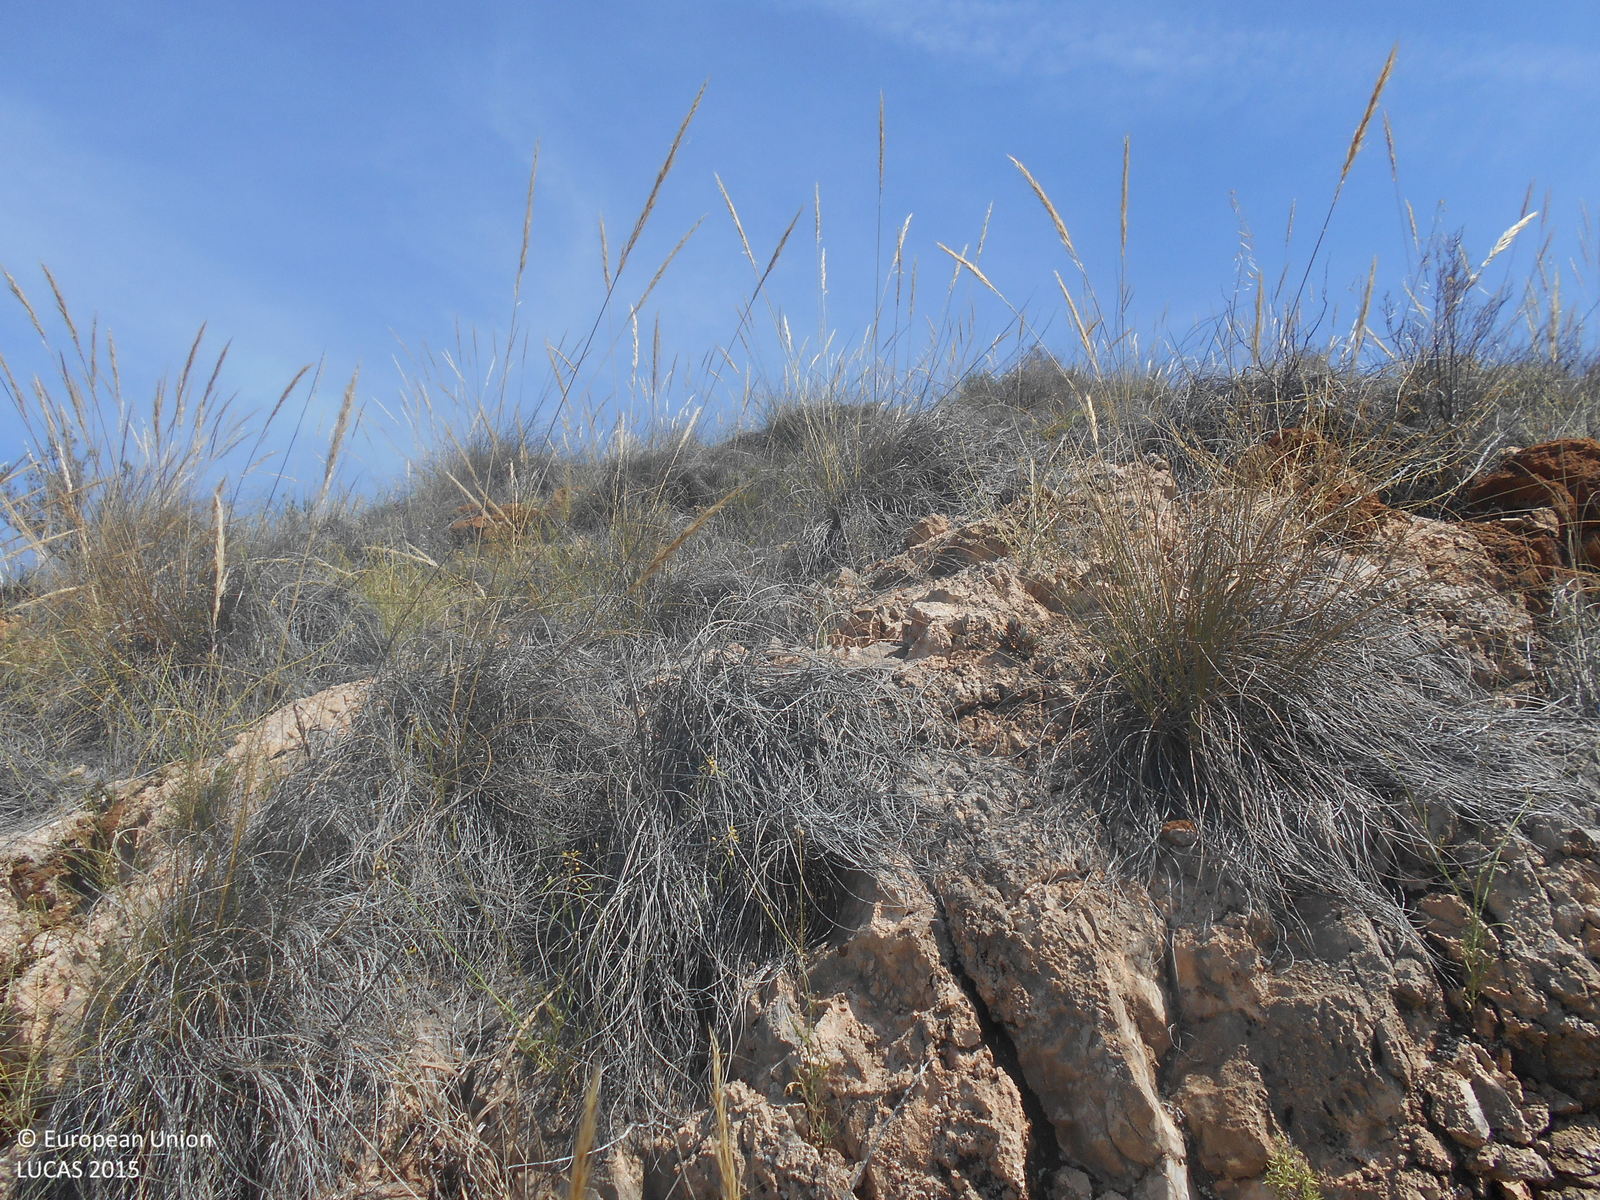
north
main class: Shrubland
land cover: Shrubland without tree cover
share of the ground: > 75 %
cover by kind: shrubs 70 %, consolidated bare surface 20 %, unconsolidated bare surface 10 %
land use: Semi-natural and natural areas not in use
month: May
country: ES
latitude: 37.6199
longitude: -1.4577
